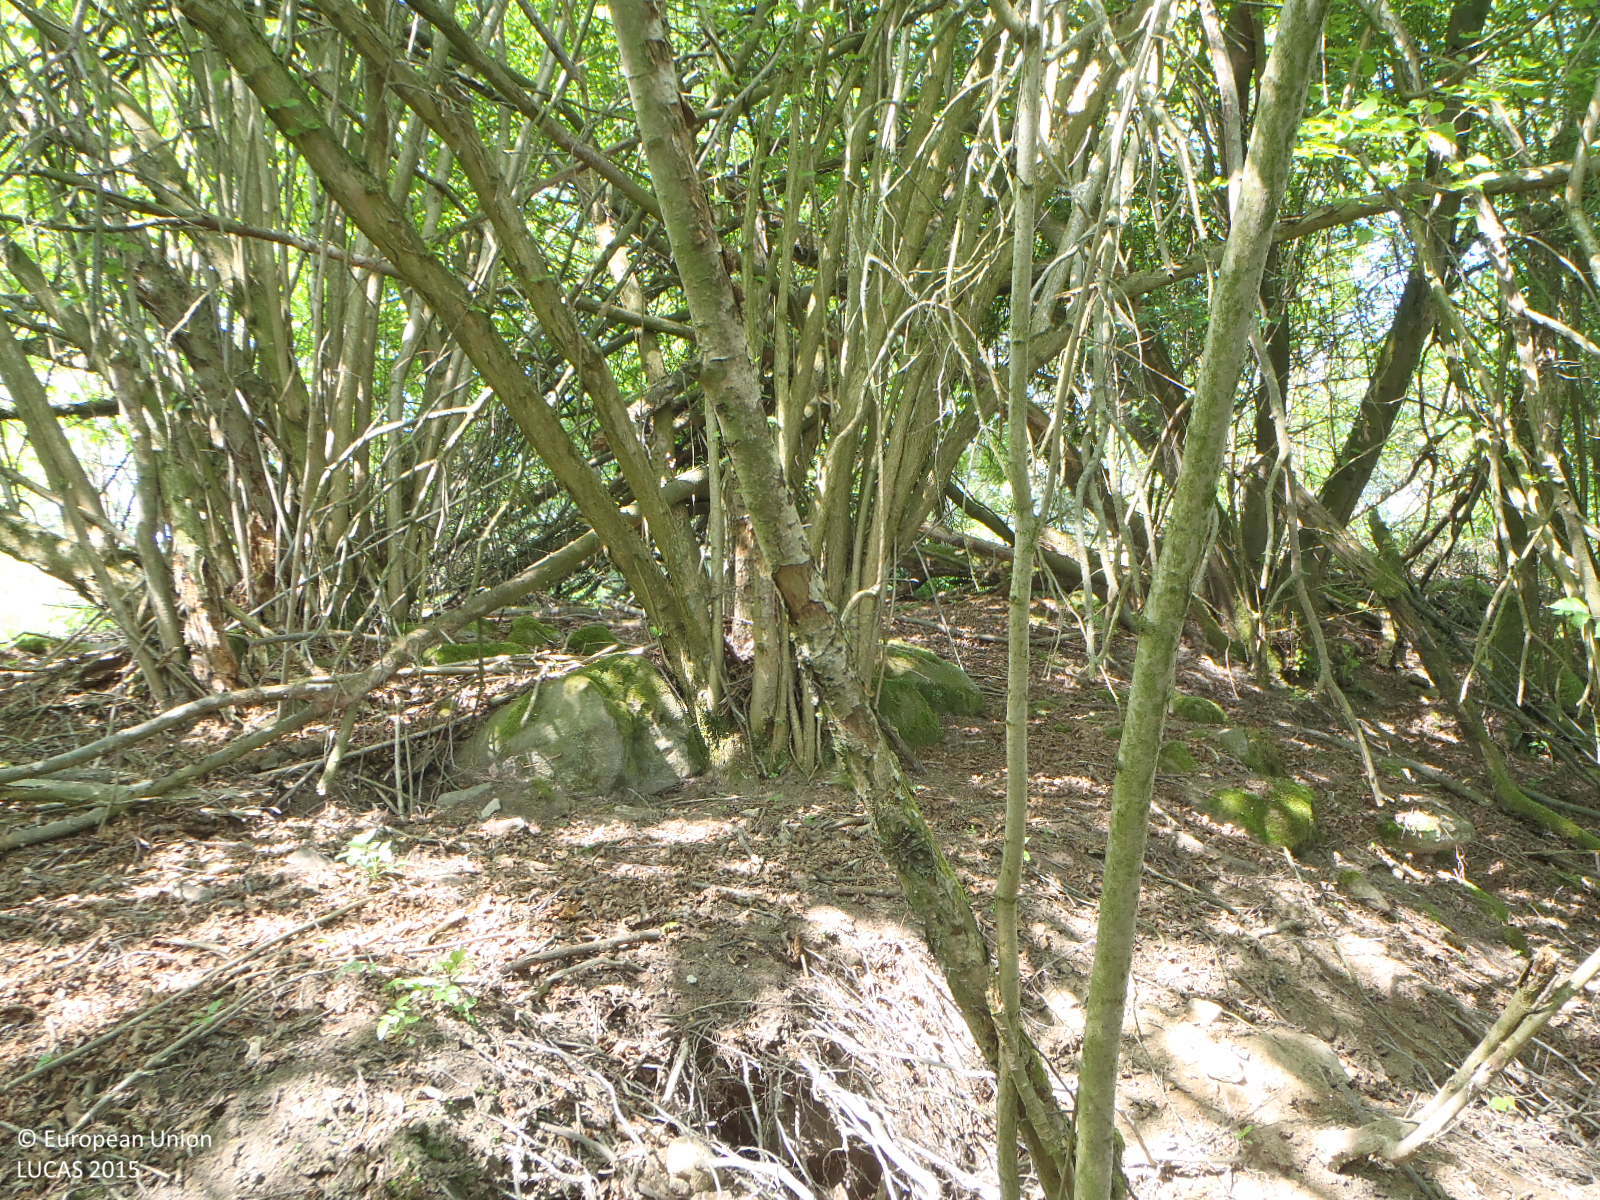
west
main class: Woodland
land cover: Broadleaved woodland
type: mesophytic deciduous forest
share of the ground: > 75 %
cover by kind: broadleaved forest trees 90 %, lichens and mosses 5 %, unconsolidated bare surface 5 %
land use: Semi-natural and natural areas not in use
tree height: > 5 m
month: May
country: CZ
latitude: 49.0452
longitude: 15.0506
